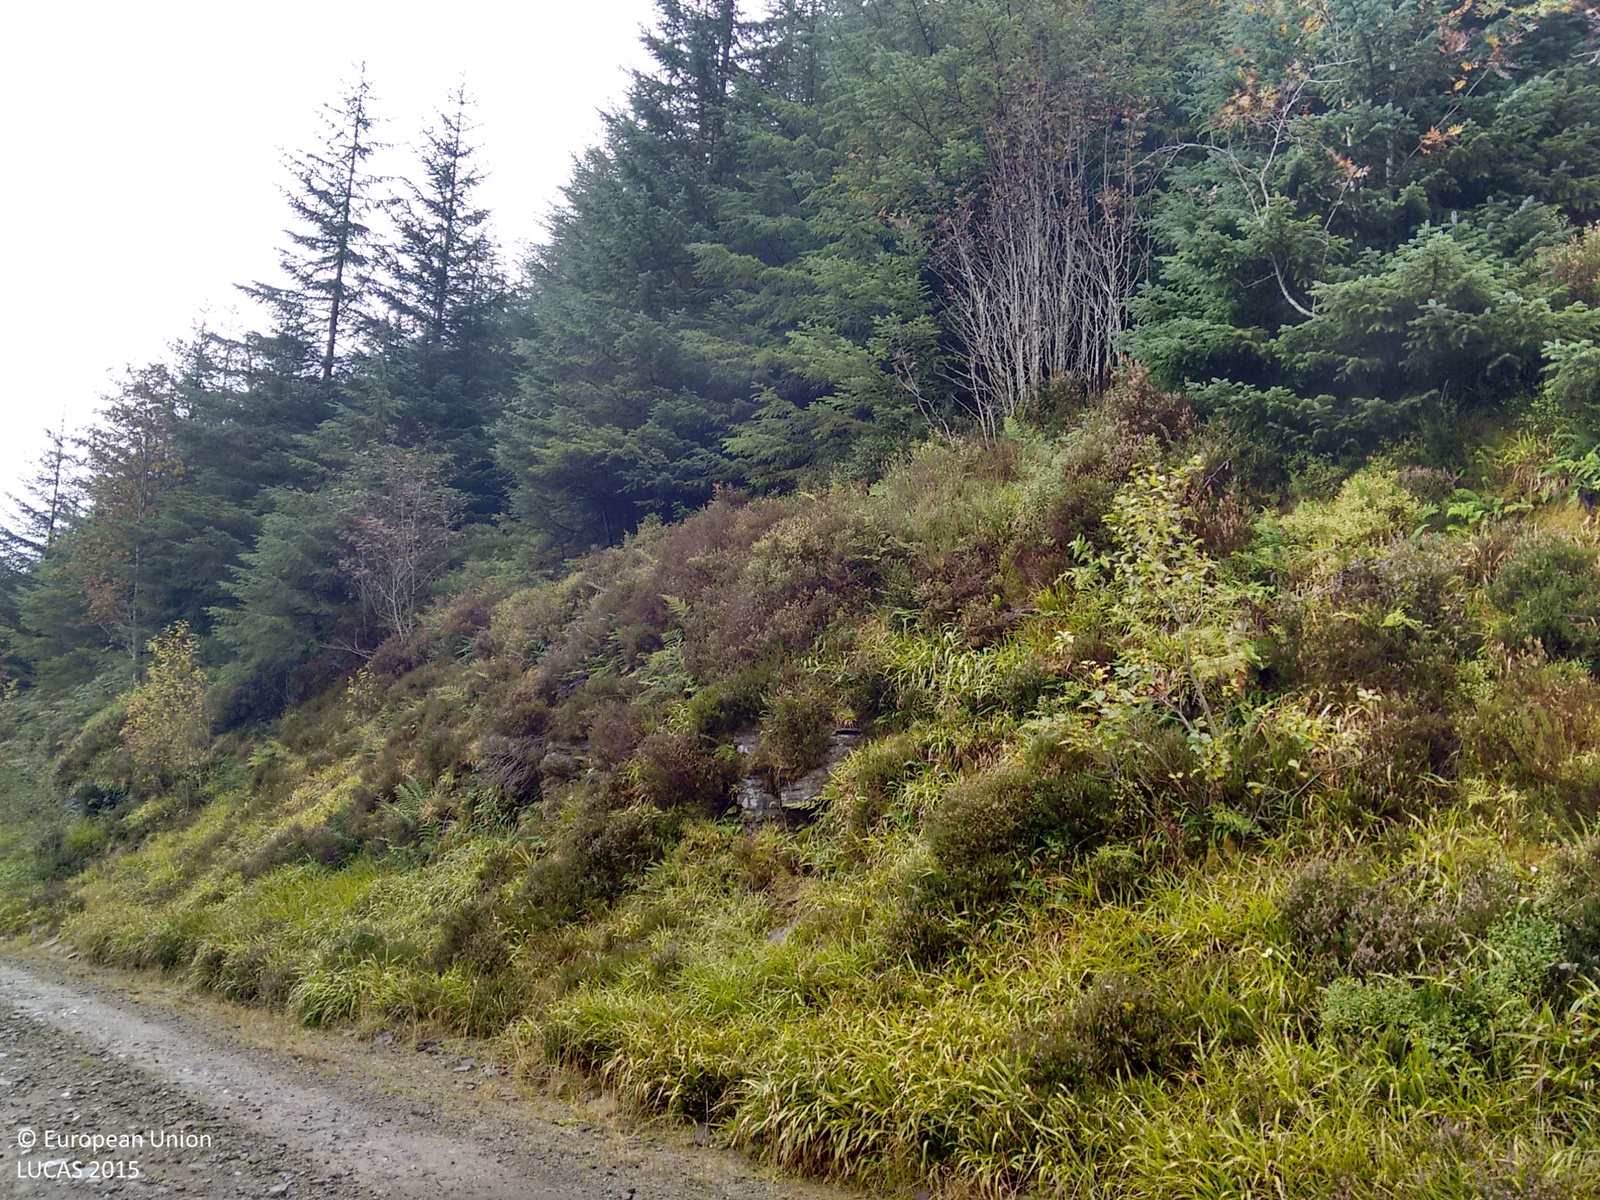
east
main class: Woodland
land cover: Pine dominated coniferous woodland
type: exotic forest
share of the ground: > 75 %
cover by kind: coniferous forest trees 80 %, shrubs 20 %
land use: Forestry
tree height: > 5 m
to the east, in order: Pine dominated coniferous woodland; Grass margins; Tracks; Grass margins; Spruce dominated coniferous woodland
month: October
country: GB
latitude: 52.2779
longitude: -3.1667
